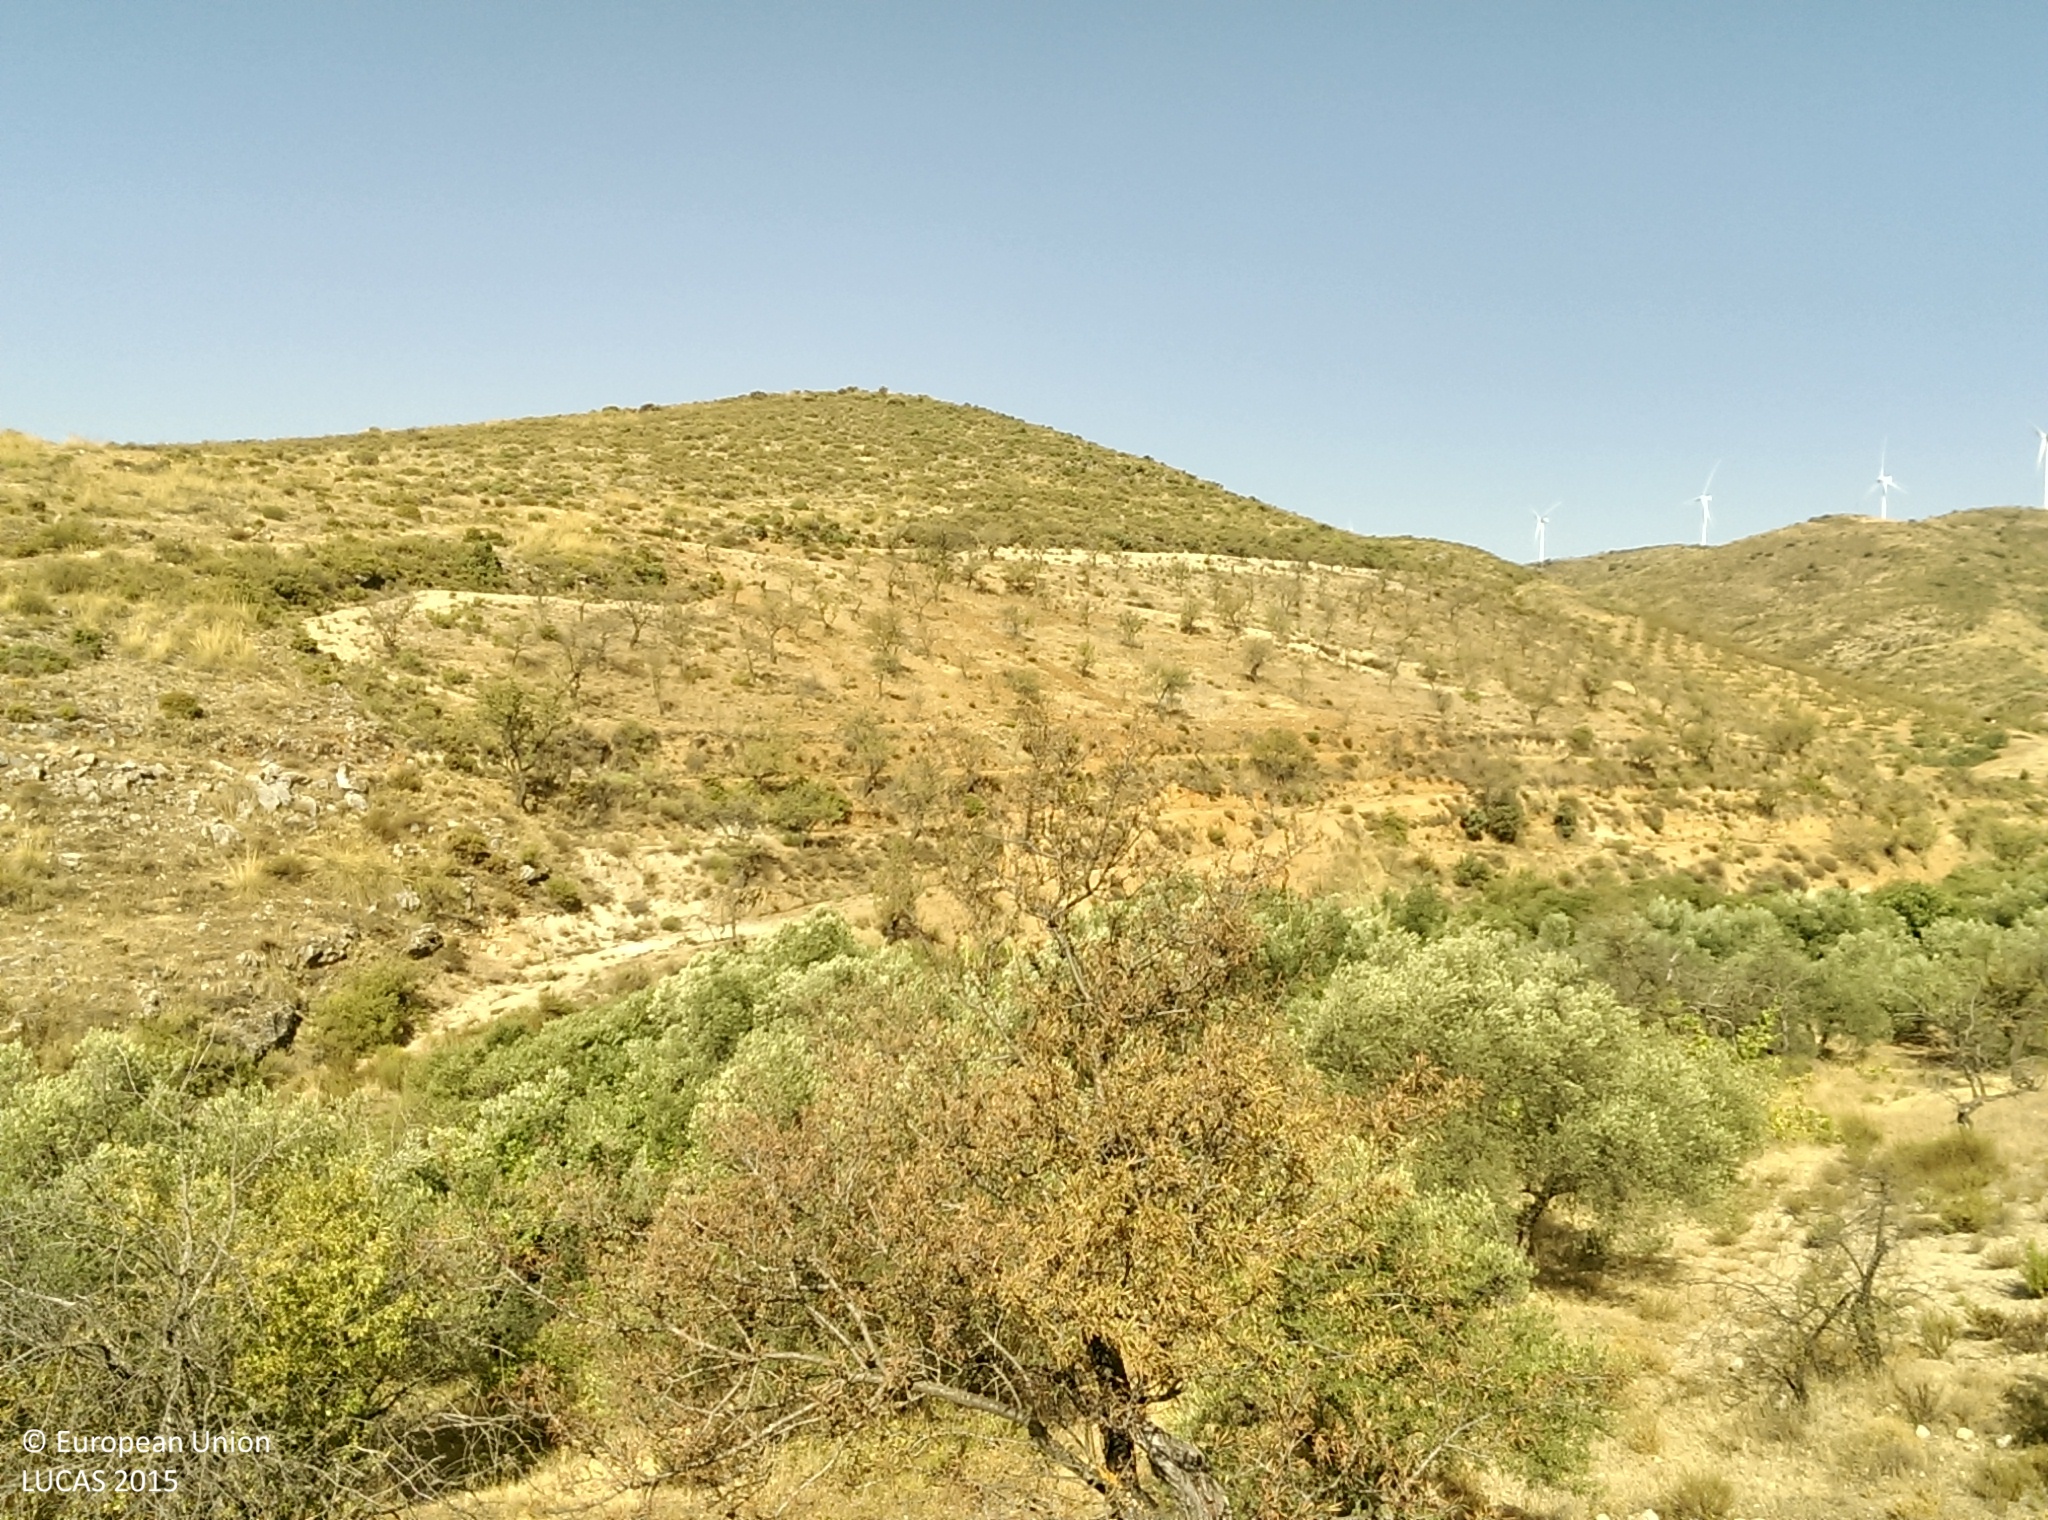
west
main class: Cropland
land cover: Nuts trees
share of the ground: 10 - 25 %
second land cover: Spontaneously vegetated surfaces
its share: 50 - 75 %
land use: Agriculture (excluding fallow land and kitchen gardens)
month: August
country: ES
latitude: 36.9418
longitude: -3.6509
